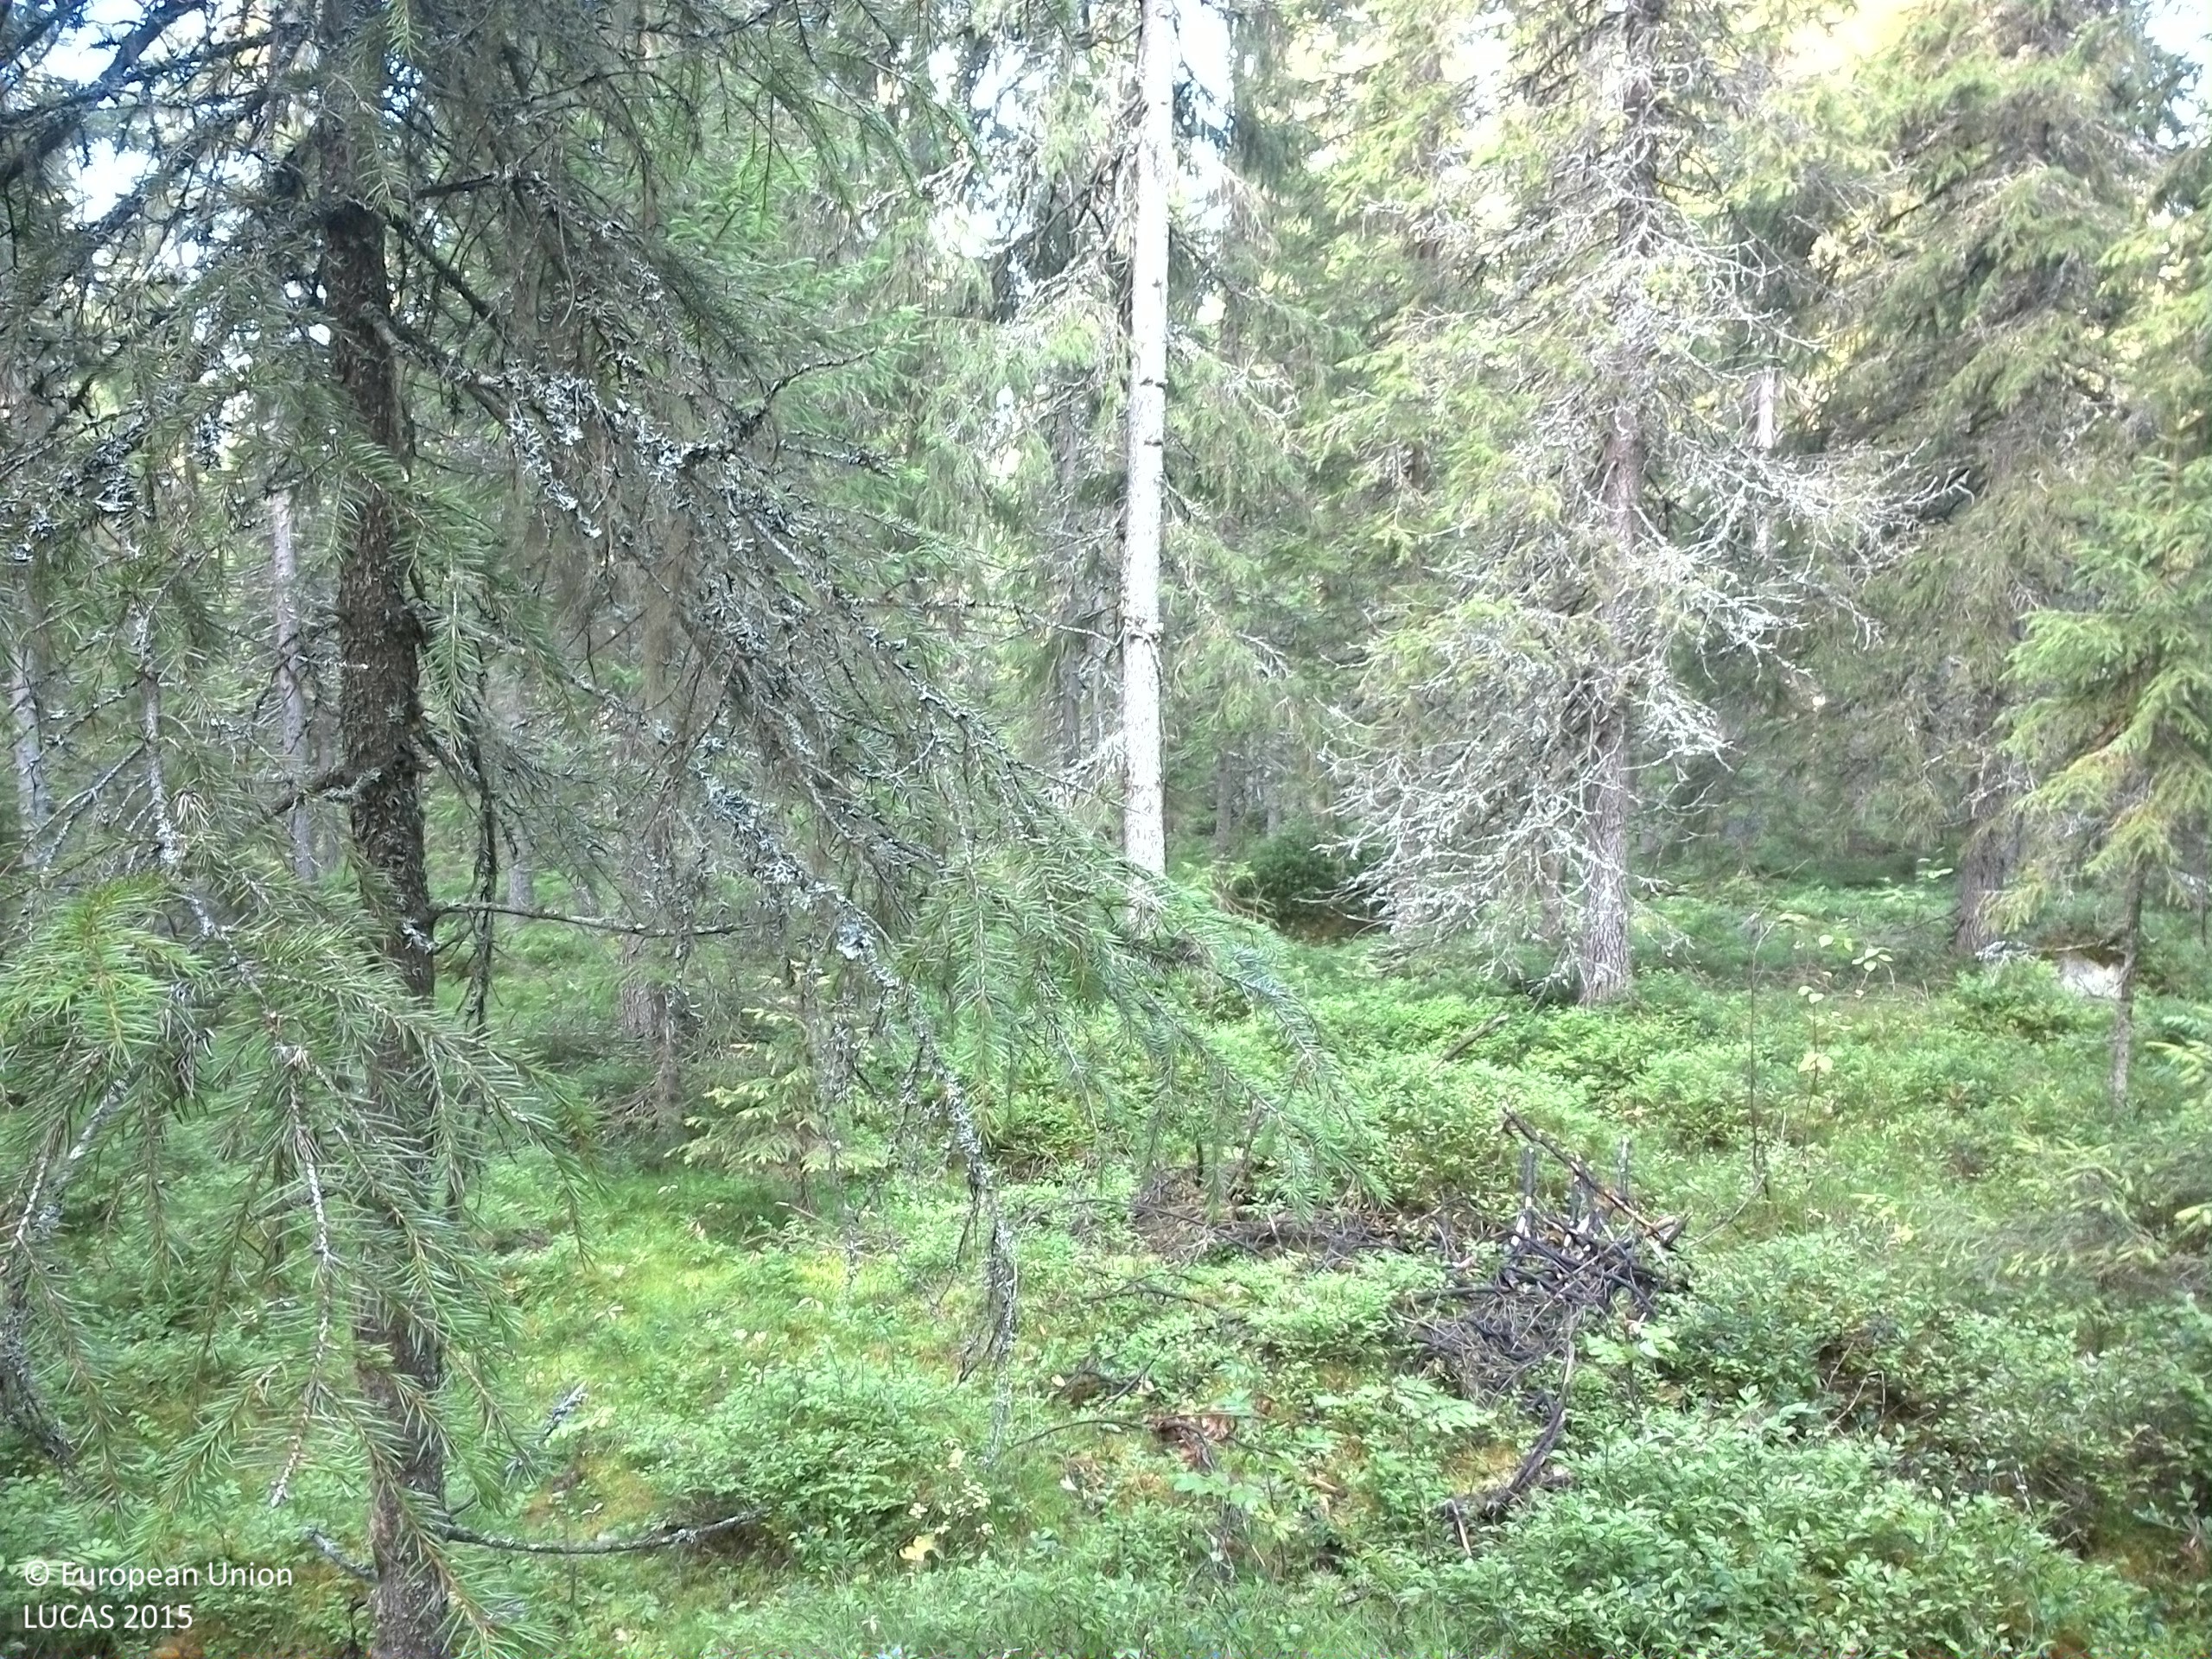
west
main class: Woodland
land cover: Spruce dominated coniferous woodland
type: boreal forest
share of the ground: 50 - 75 %
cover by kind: coniferous forest trees 55 %, shrubs 25 %, lichens and mosses 10 %, broadleaved forest trees 5 %, herbaceous plants 5 %
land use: Forestry
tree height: > 5 m
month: September
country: SE
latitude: 63.9525
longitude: 16.6047
